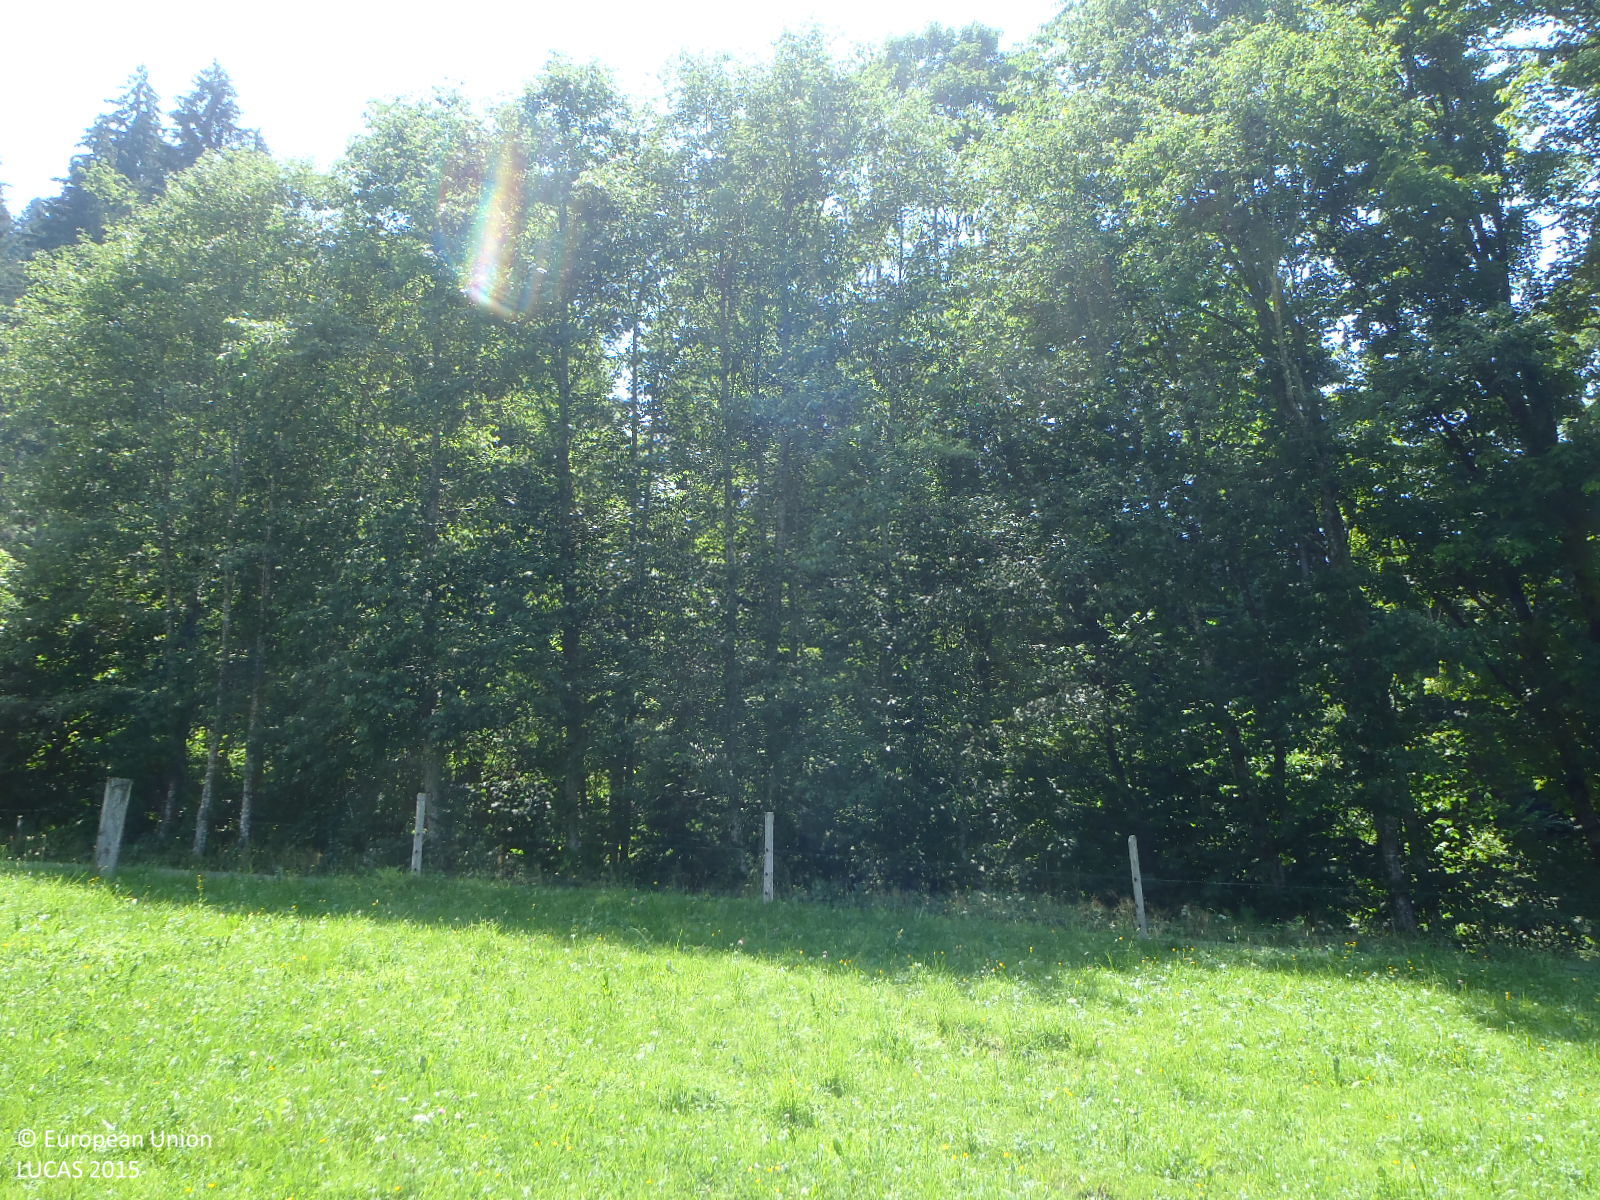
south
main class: Grassland
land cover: Grassland without tree/shrub cover
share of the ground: > 75 %
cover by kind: herbaceous plants 100 %
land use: Agriculture (excluding fallow land and kitchen gardens)
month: July
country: AT
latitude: 47.4952
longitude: 12.4009
